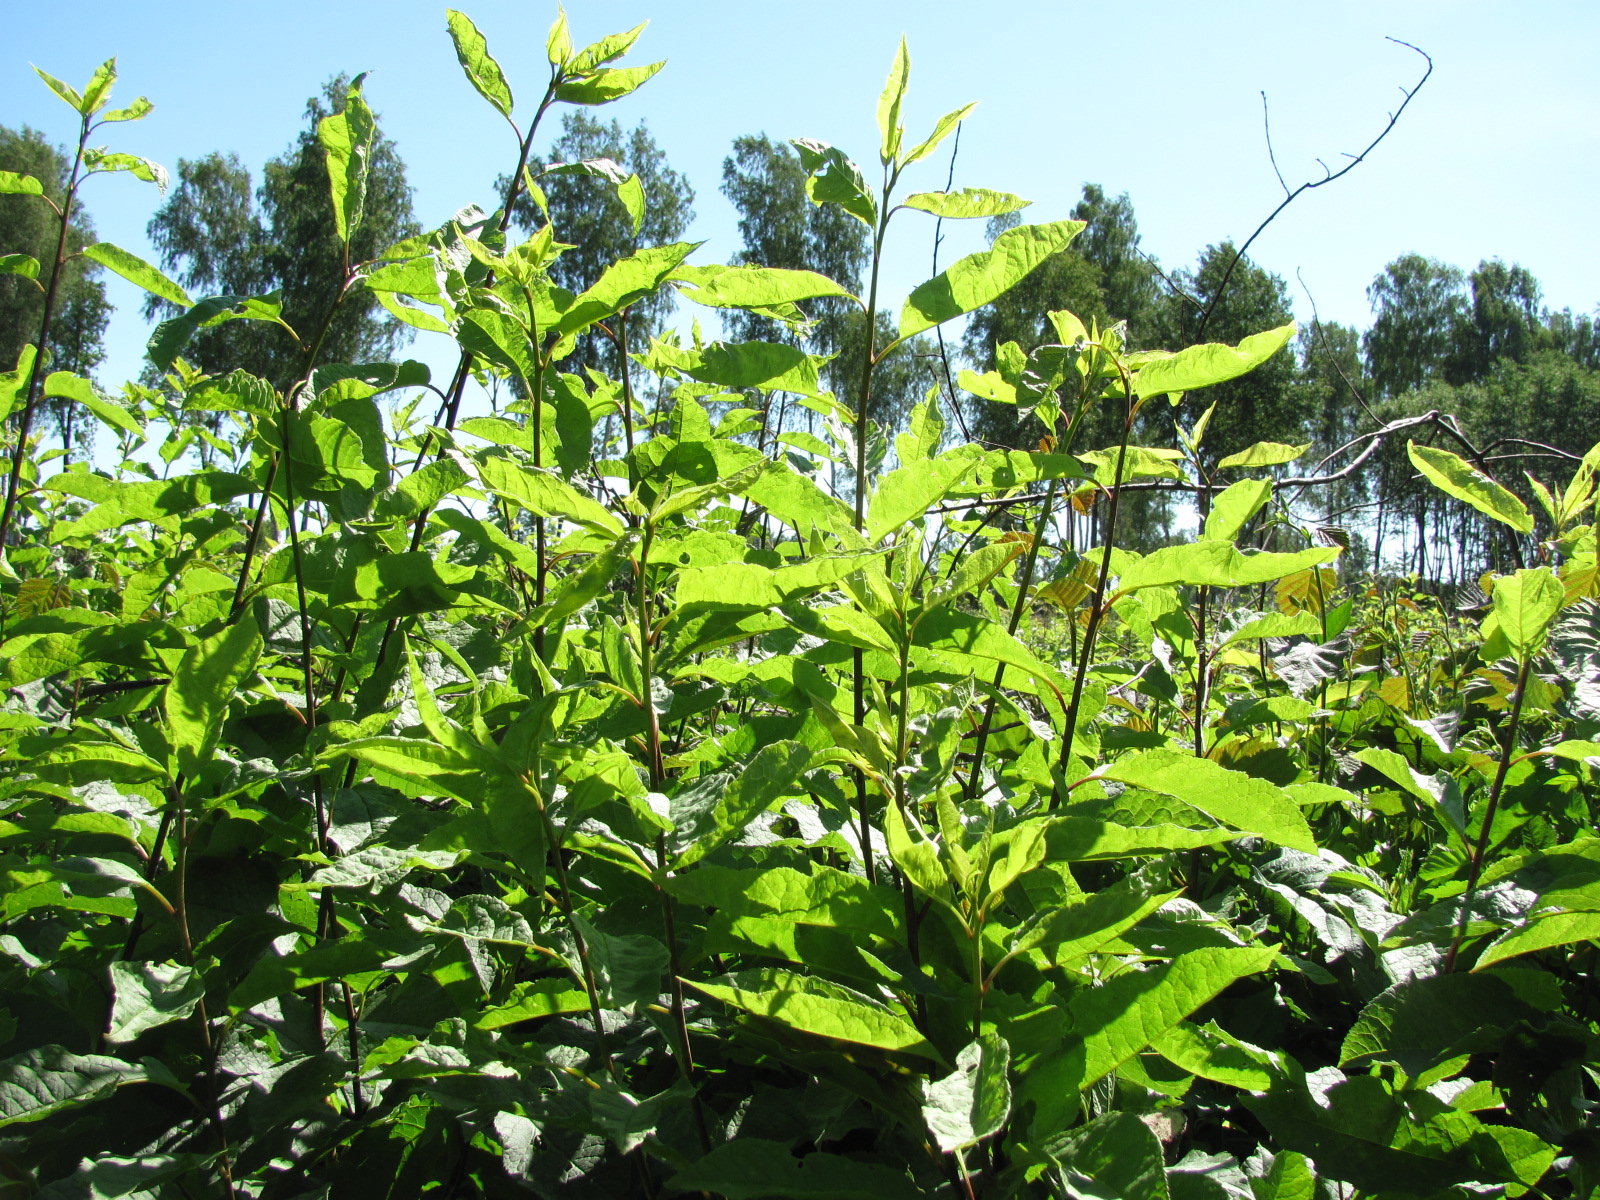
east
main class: Woodland
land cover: Broadleaved woodland
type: non-riverine alder, birch or aspen forest
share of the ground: > 75 %
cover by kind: broadleaved forest trees 100 %
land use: Forestry
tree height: < 5 m
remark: Clear cut
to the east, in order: Broadleaved woodland
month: June
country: LV
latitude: 56.3595
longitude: 23.8897
